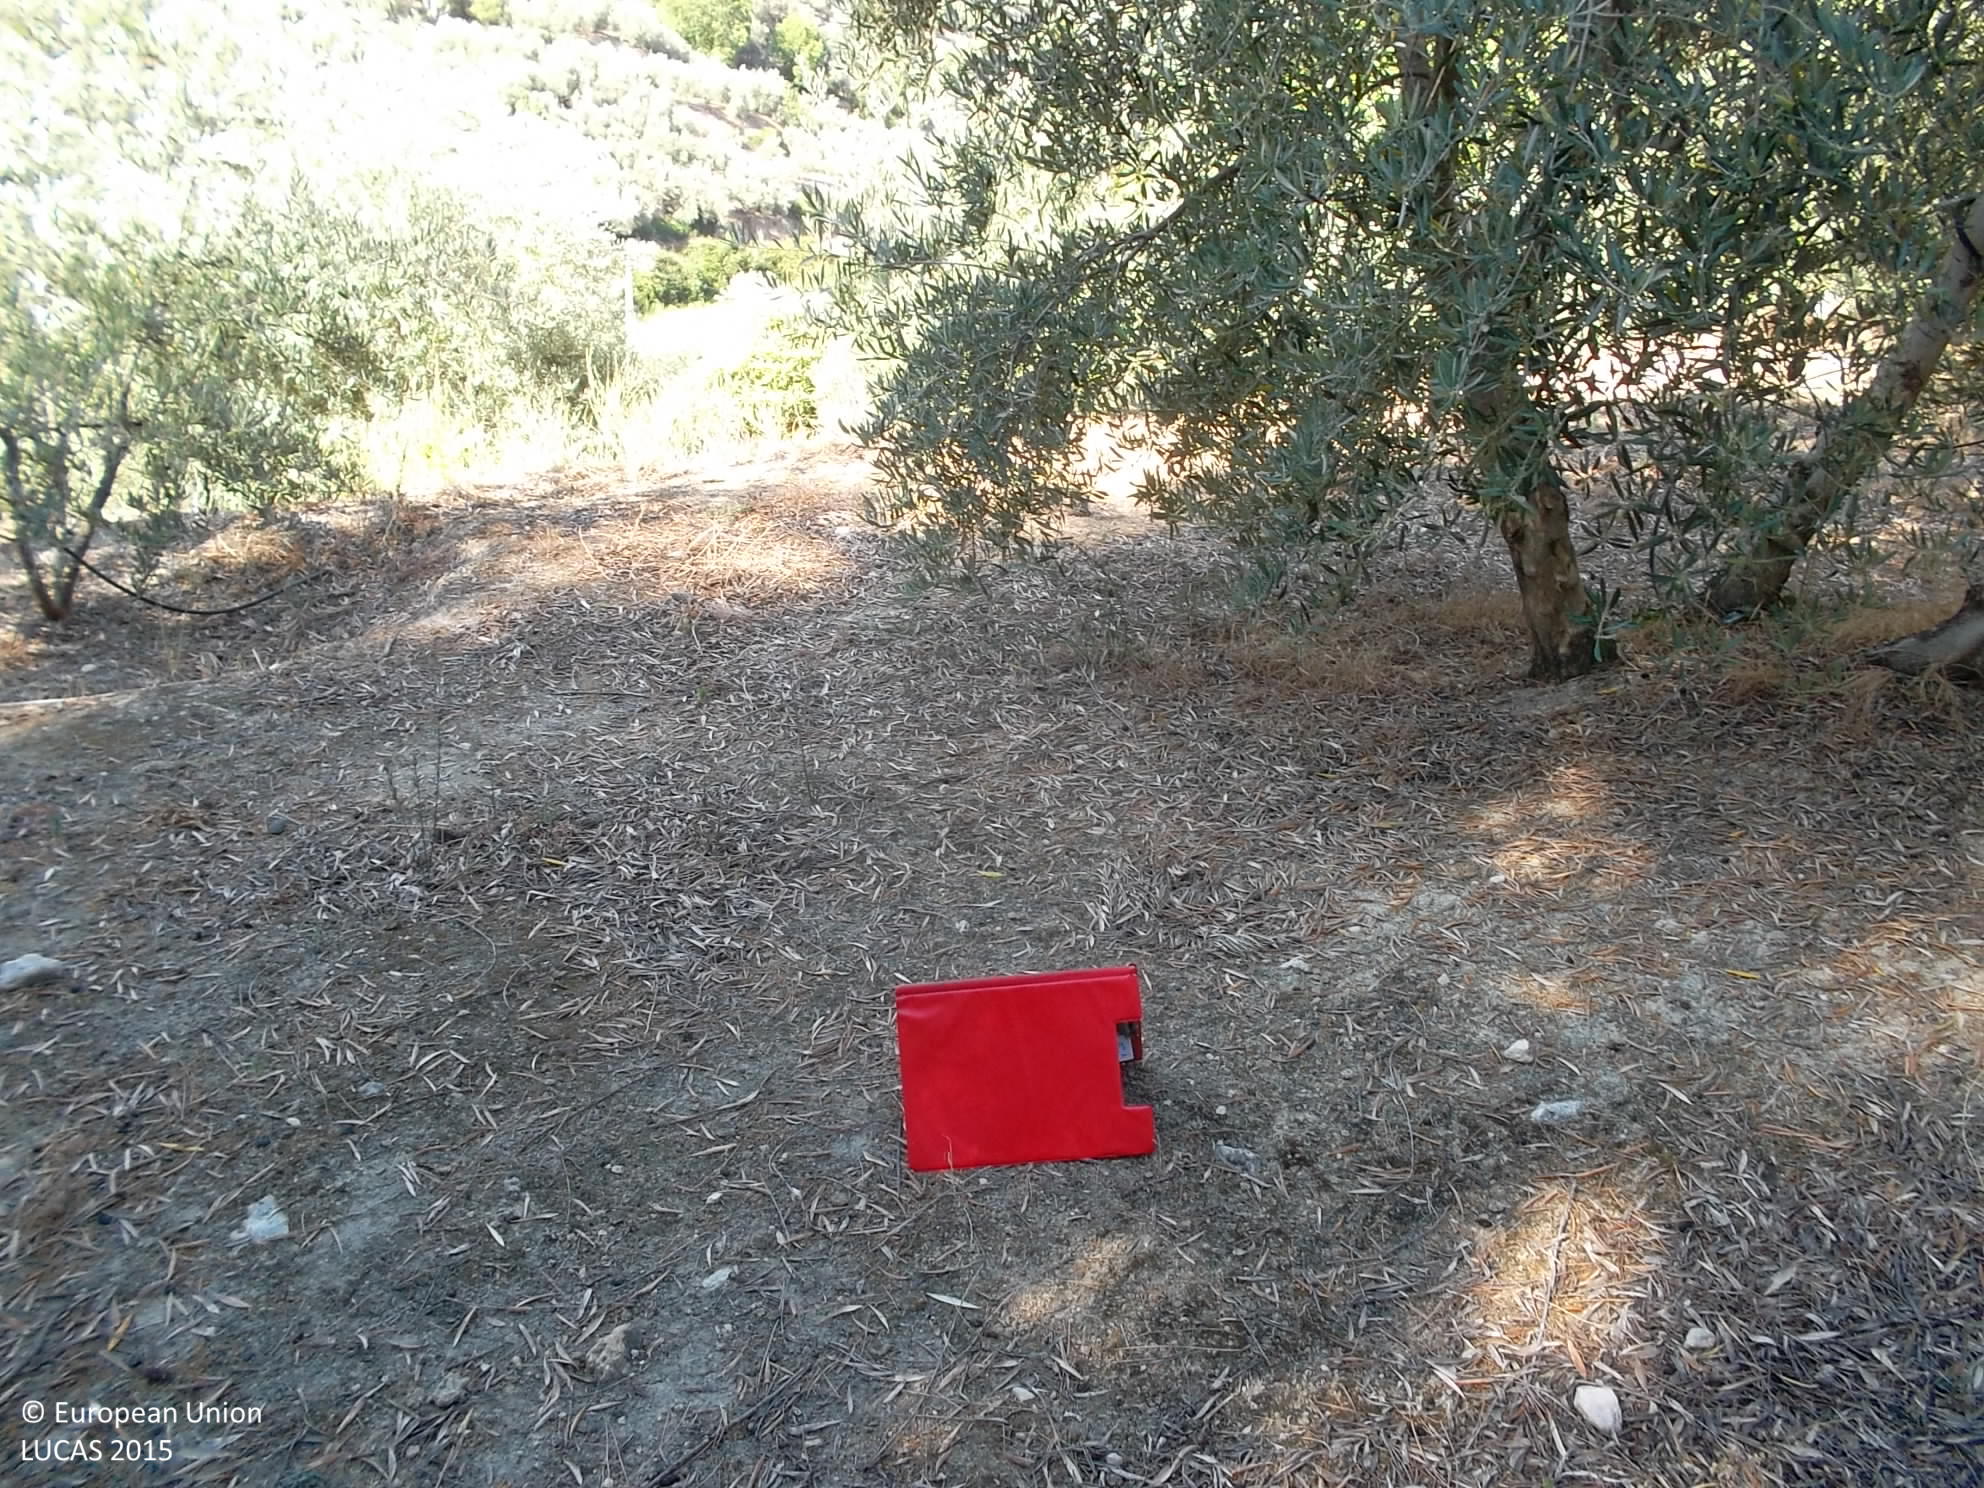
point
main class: Cropland
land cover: Olive groves
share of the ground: 25 - 50 %
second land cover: Other bare soil
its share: > 75 %
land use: Agriculture (excluding fallow land and kitchen gardens)
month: June
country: ES
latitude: 37.8524
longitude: -3.0533
